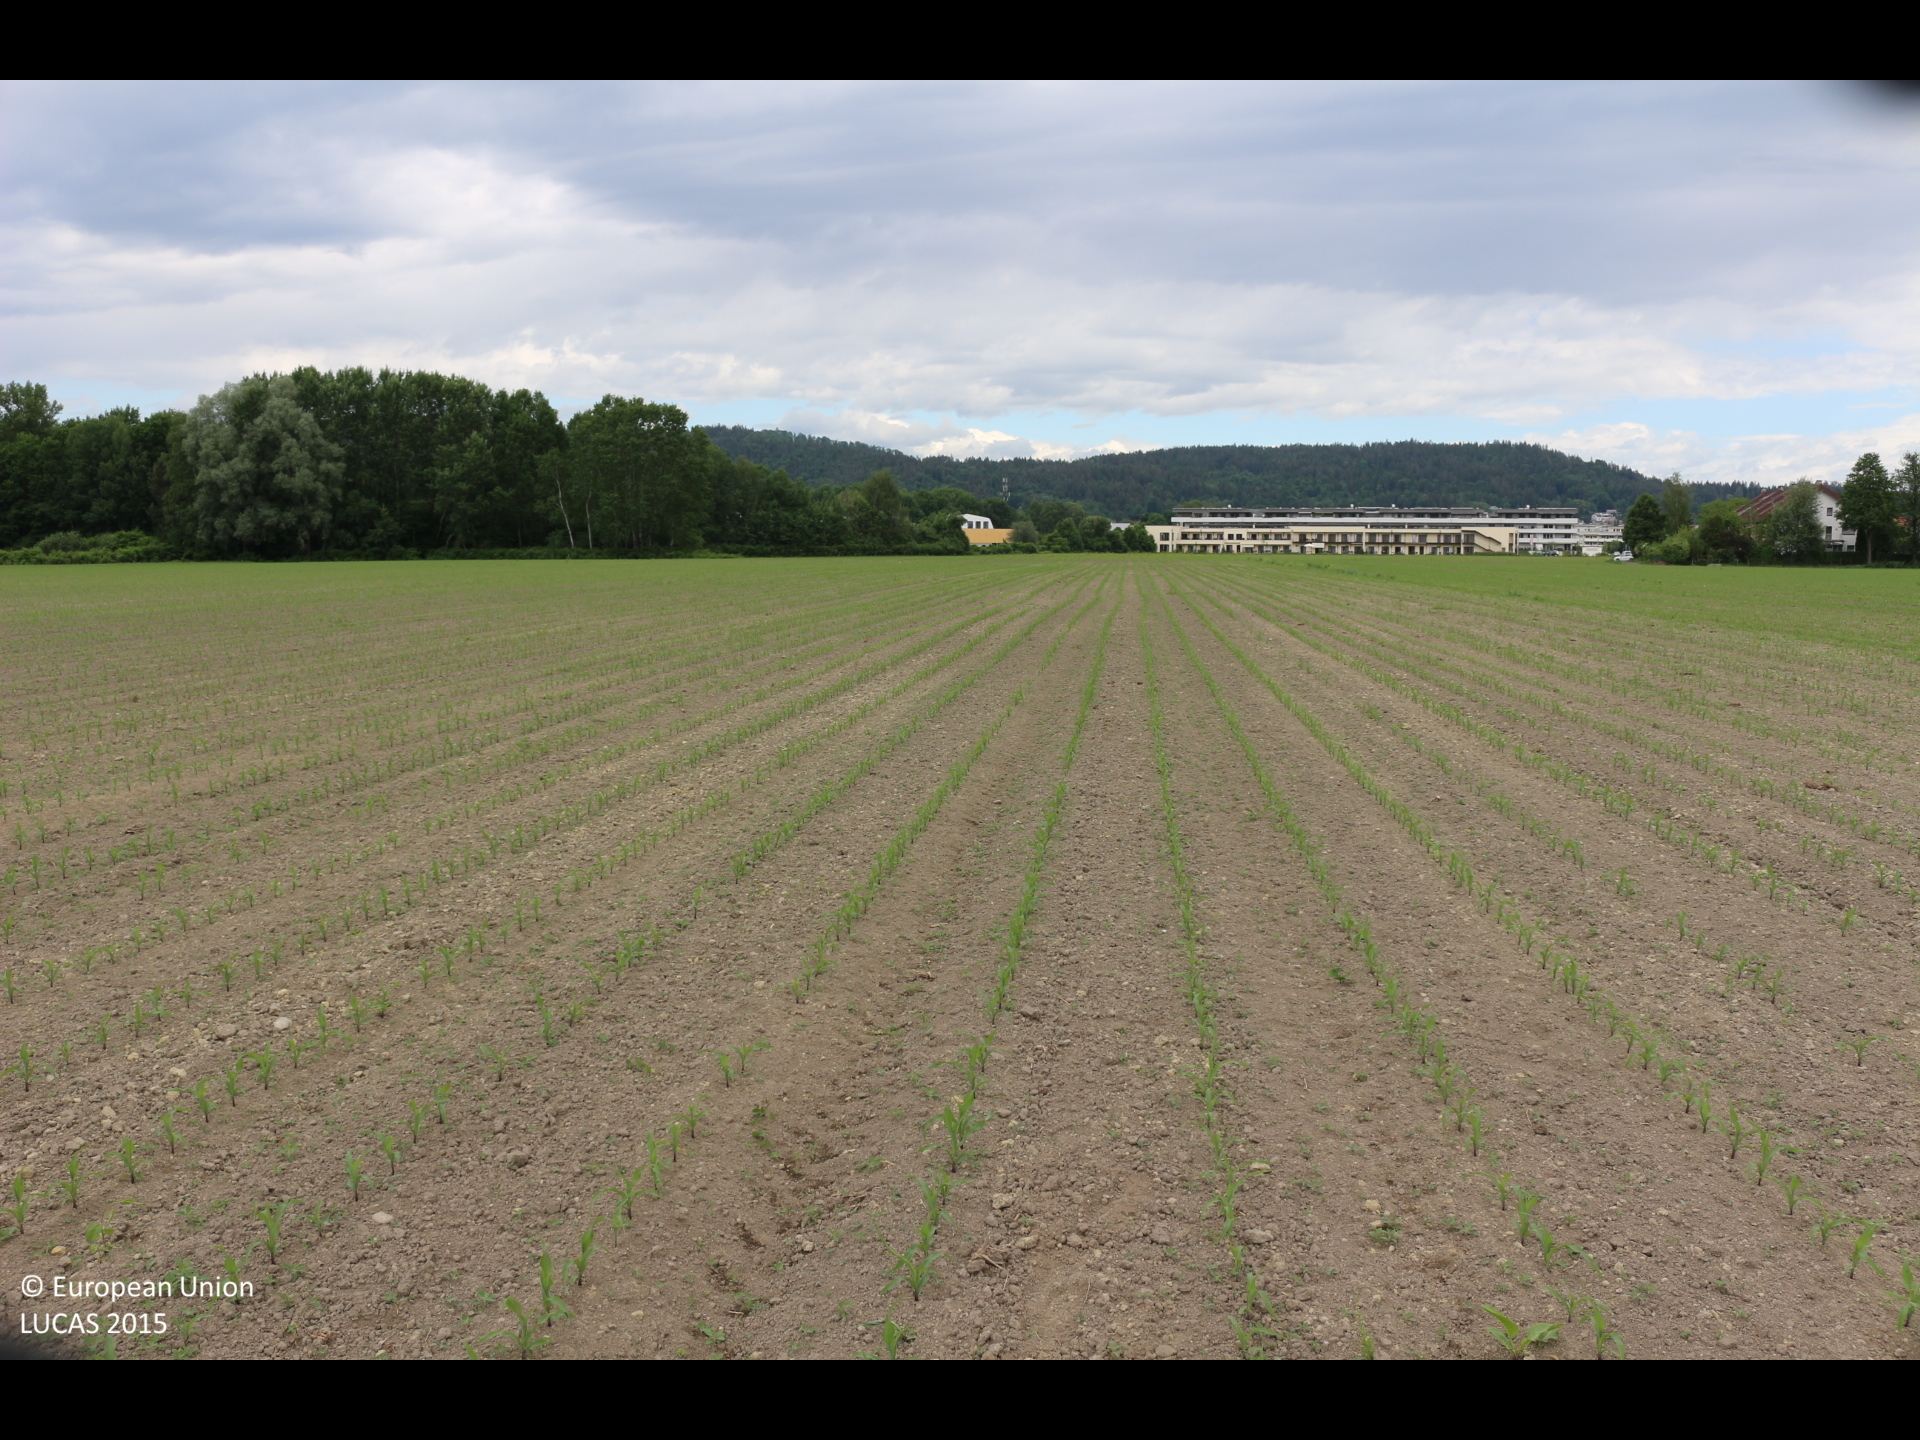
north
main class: Cropland
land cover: Maize
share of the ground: 10 - 25 %
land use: Agriculture (excluding fallow land and kitchen gardens)
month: May
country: AT
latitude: 46.6088
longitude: 14.2668
